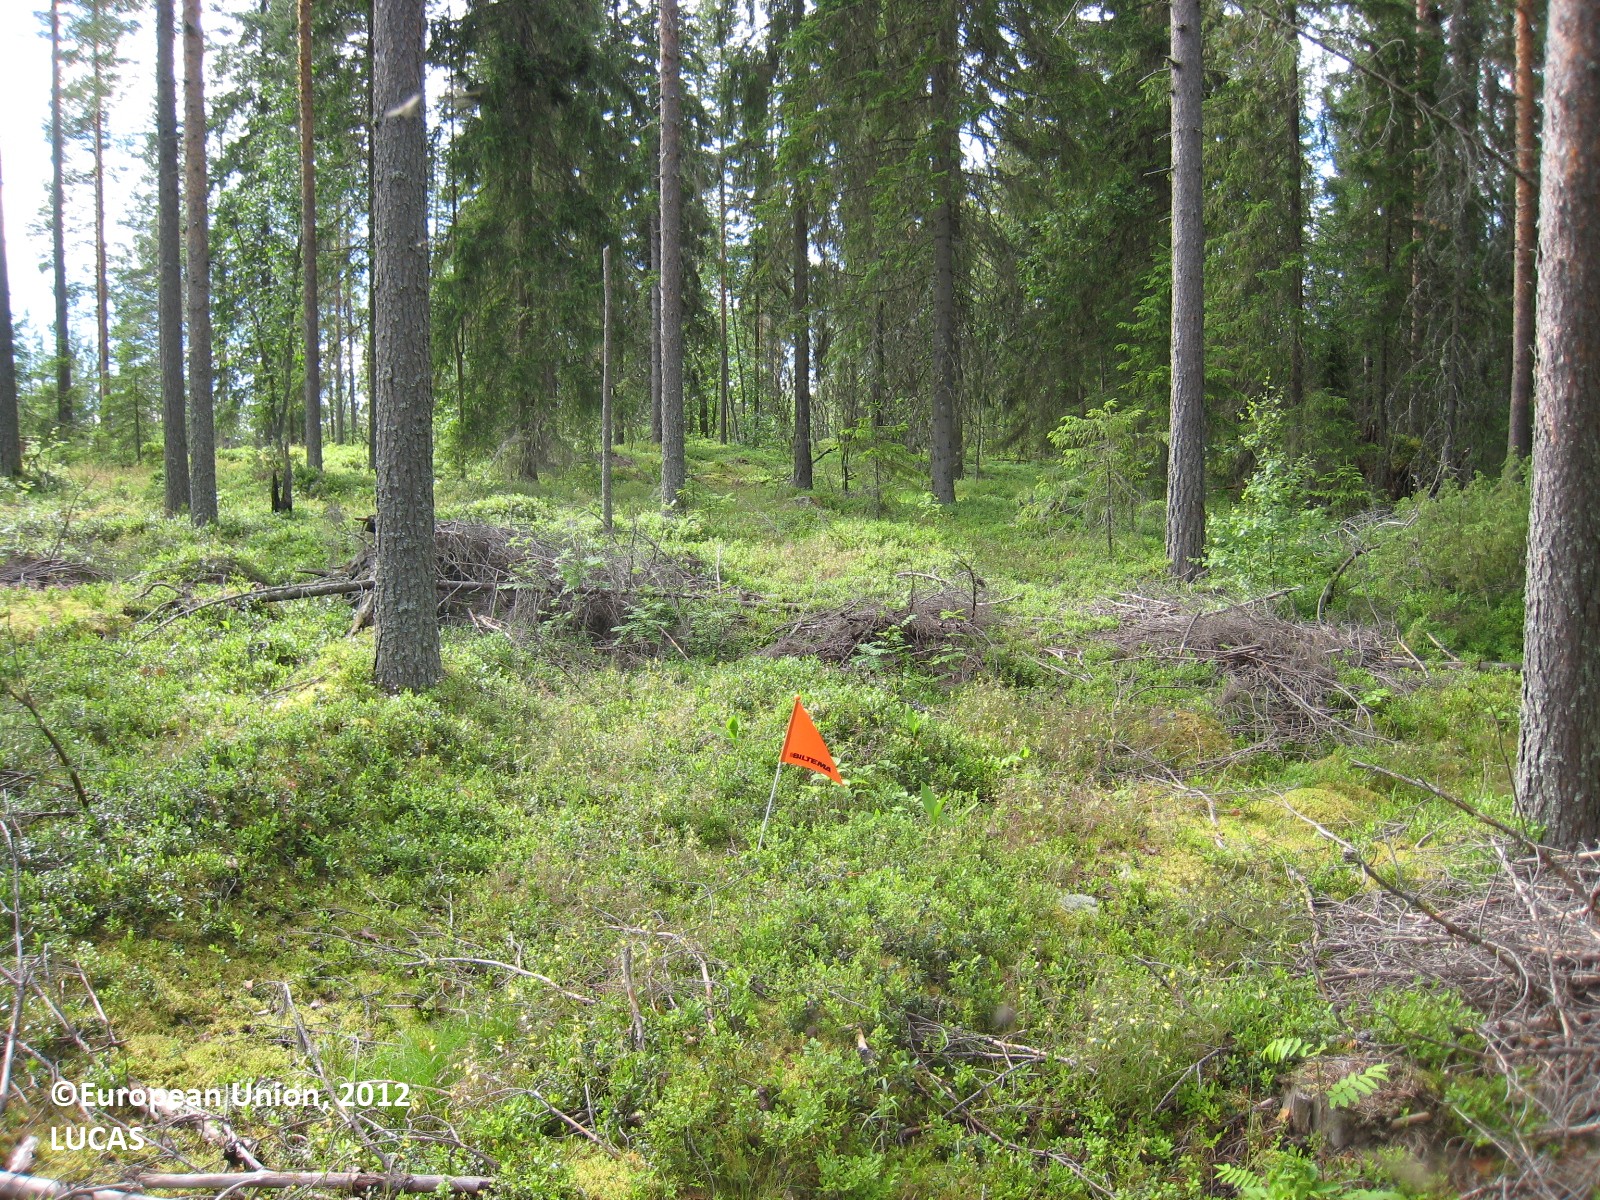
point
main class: Woodland
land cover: Other coniferous woodland
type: boreal forest
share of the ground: 50 - 75 %
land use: Forestry
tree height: > 5 m
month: July
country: FI
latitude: 62.9091
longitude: 25.6808
